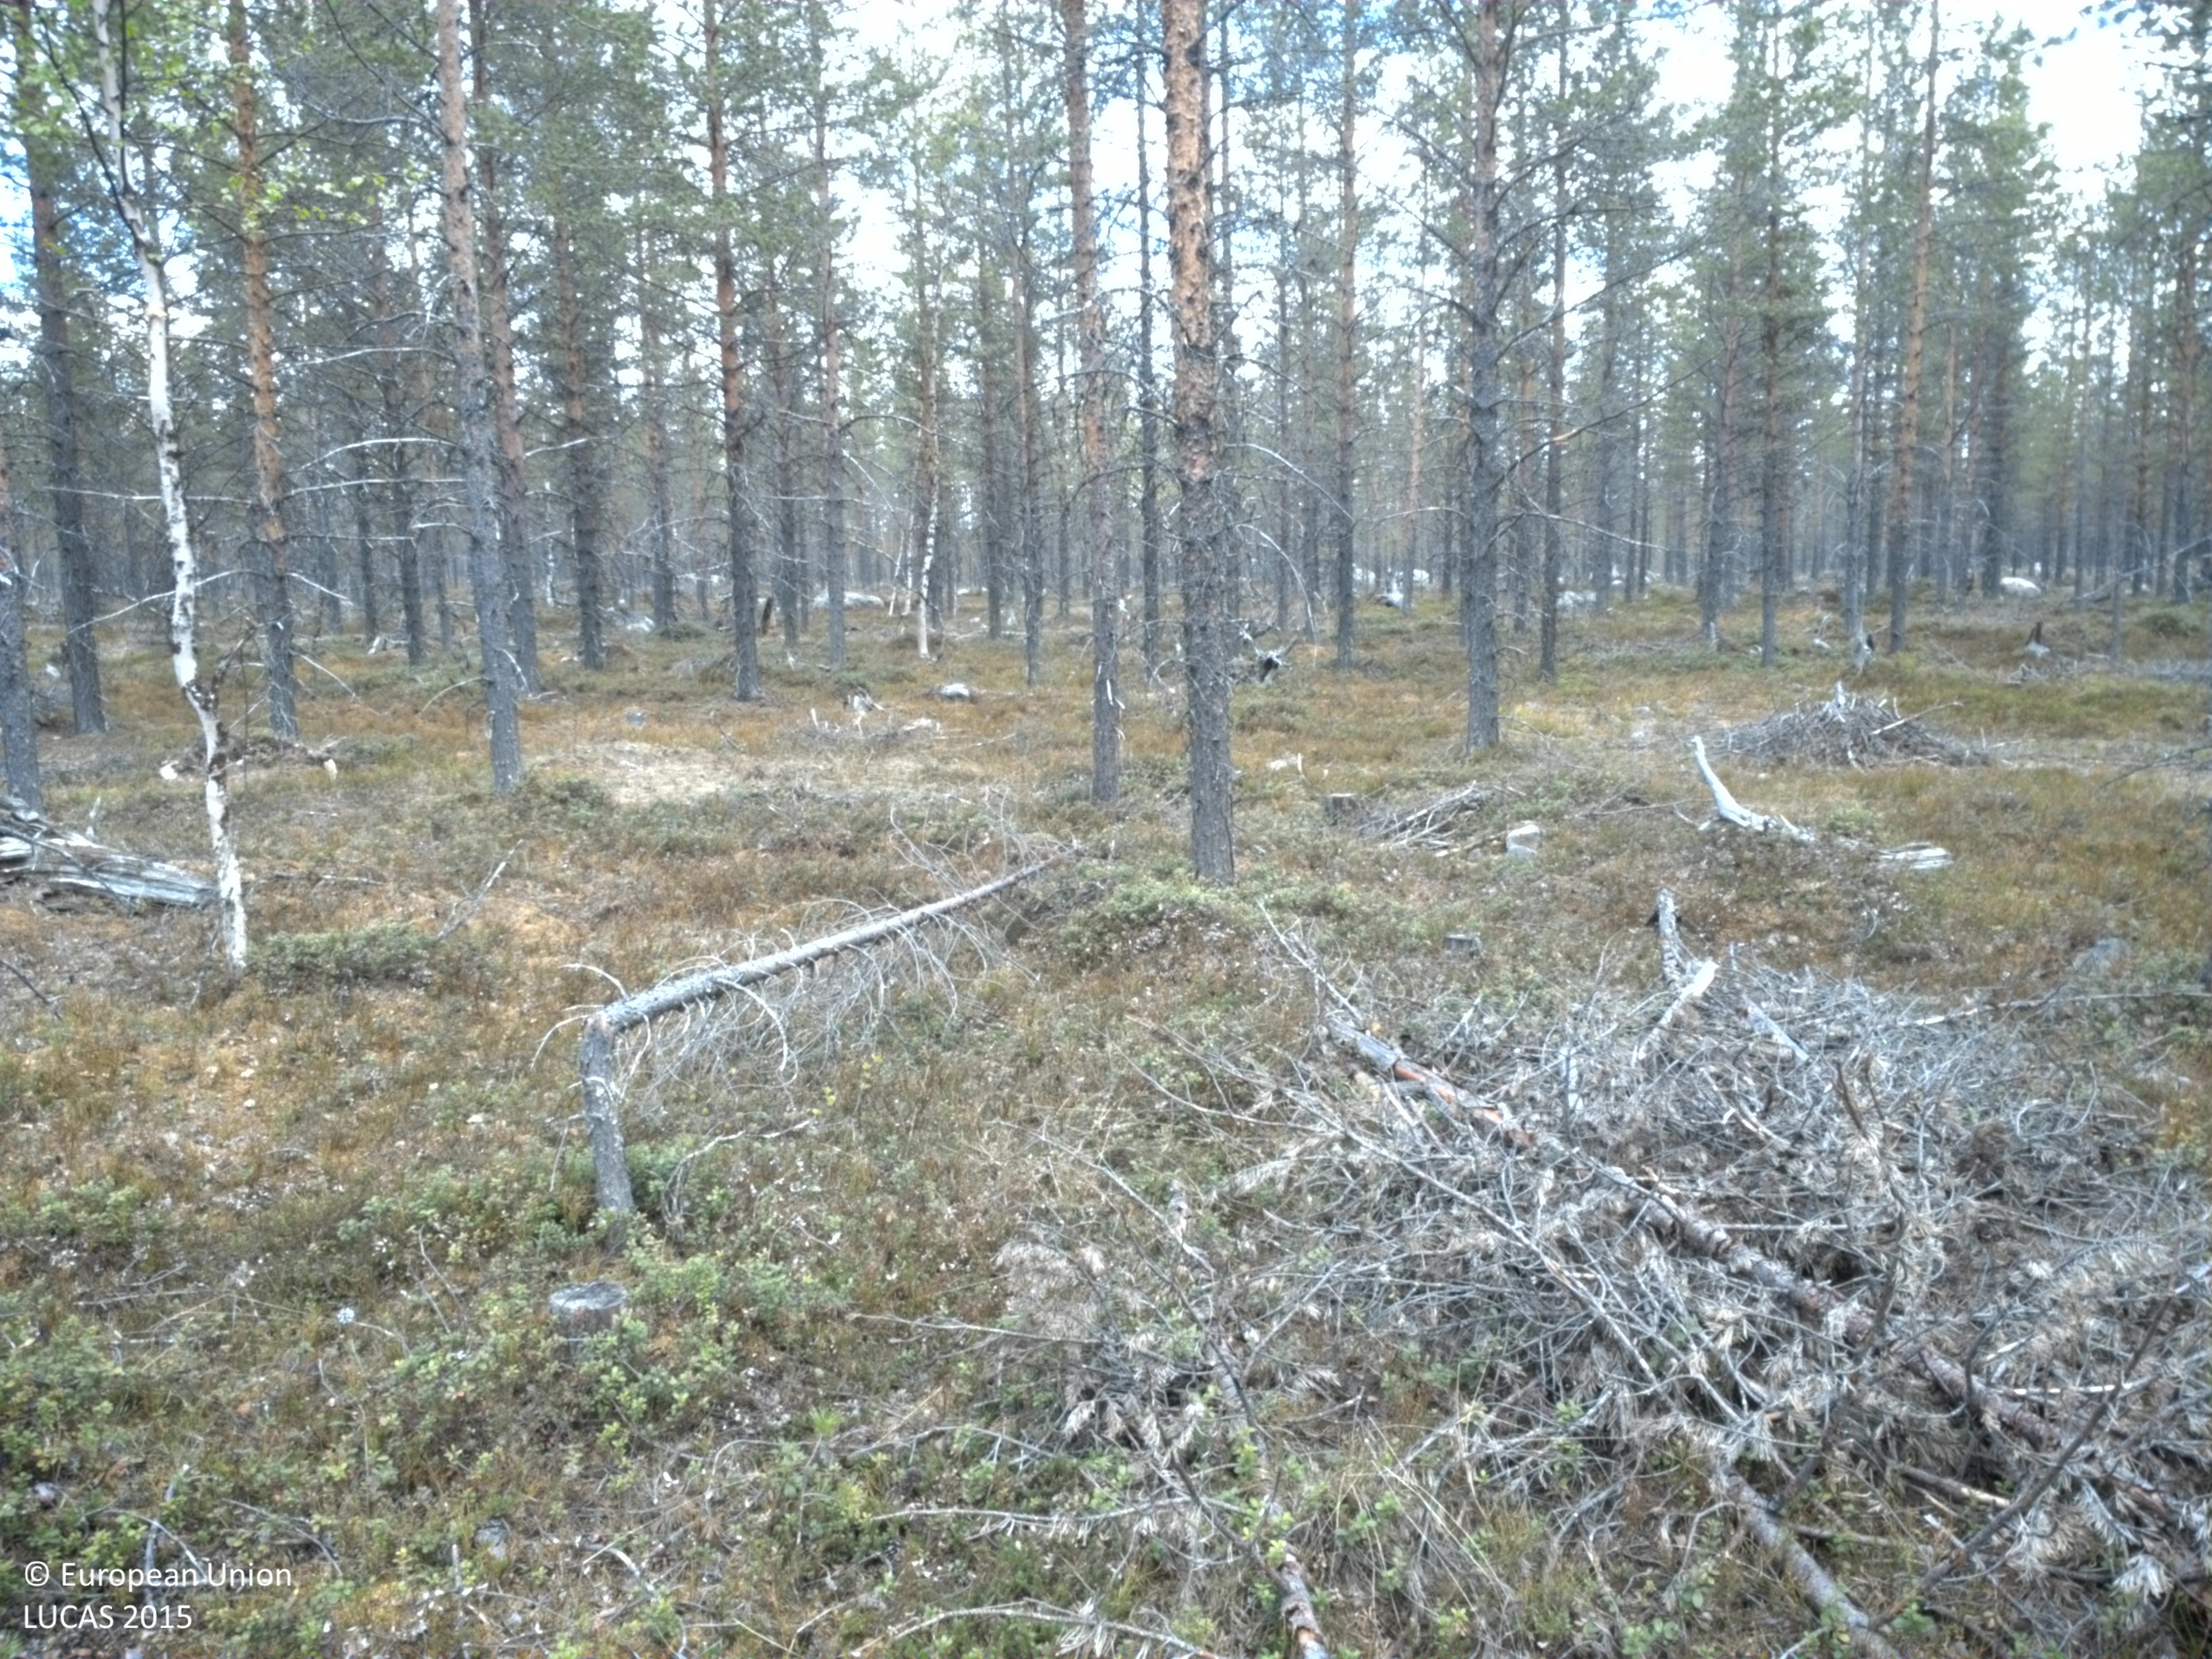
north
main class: Woodland
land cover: Pine dominated coniferous woodland
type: boreal forest
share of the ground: 25 - 50 %
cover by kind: shrubs 55 %, coniferous forest trees 40 %, lichens and mosses 5 %
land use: Forestry
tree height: > 5 m
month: June
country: SE
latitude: 66.2391
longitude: 18.6056
